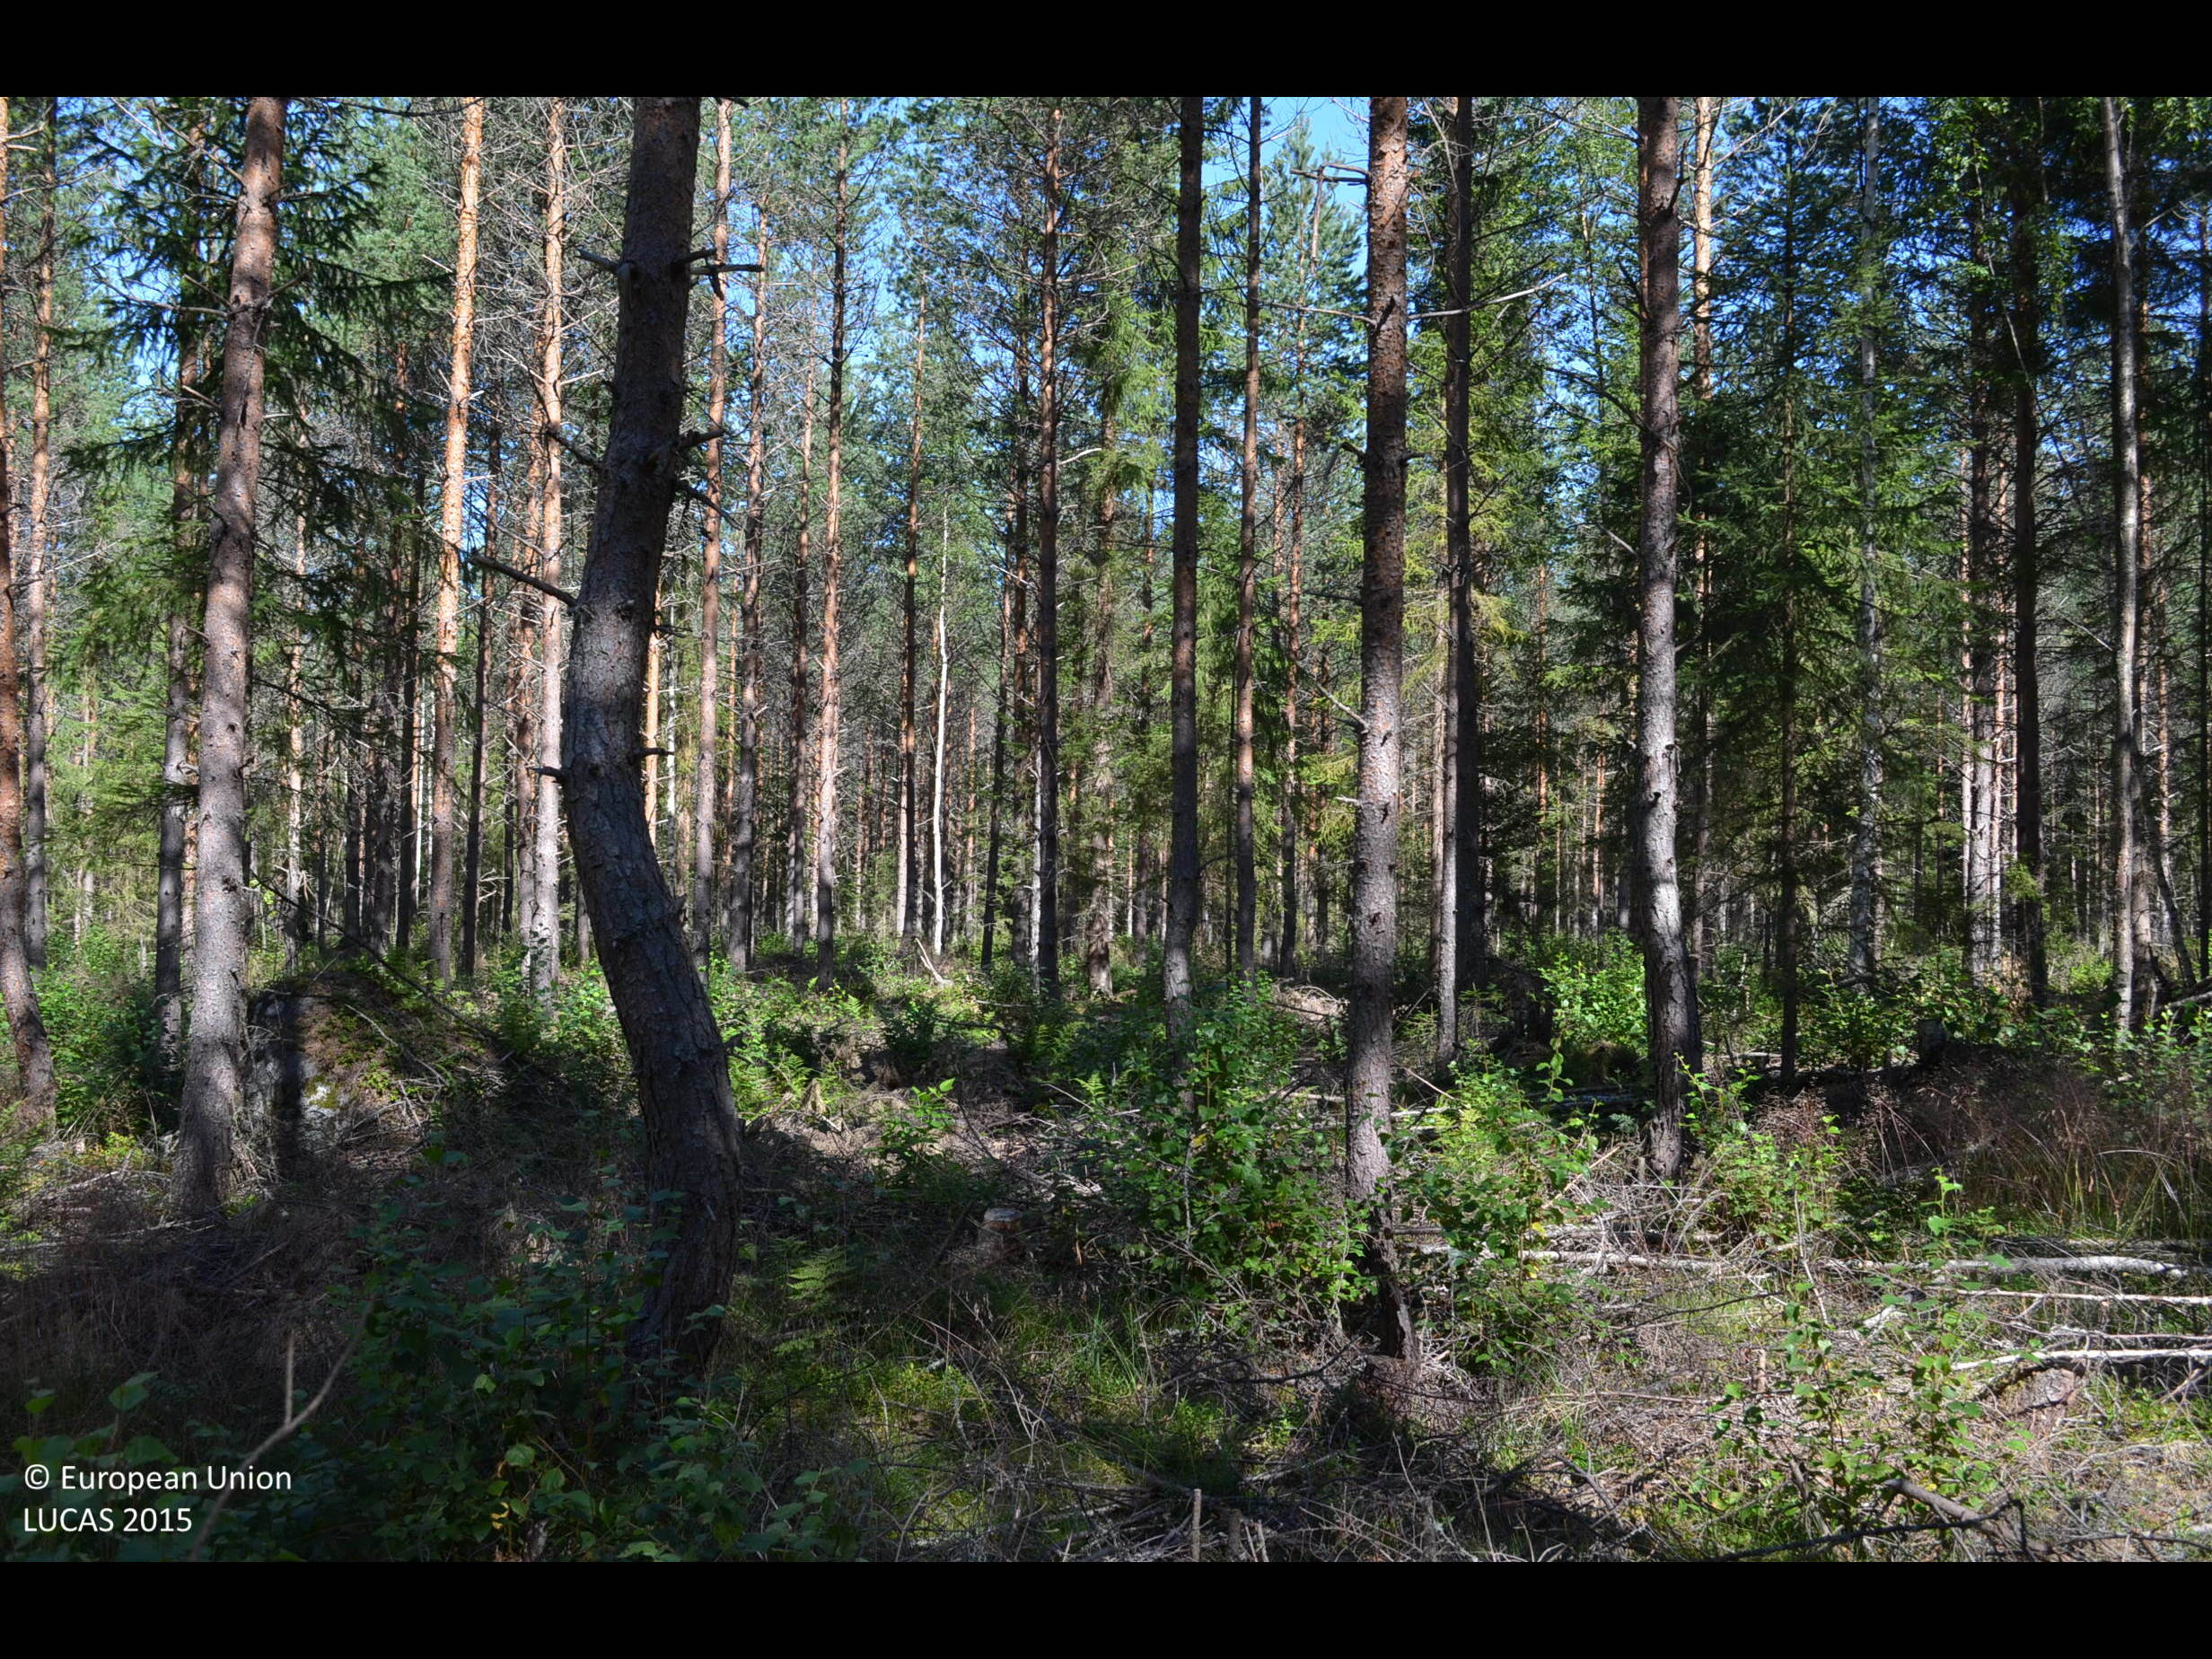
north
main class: Woodland
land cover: Pine dominated coniferous woodland
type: boreal forest
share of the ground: 50 - 75 %
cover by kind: coniferous forest trees 70 %, shrubs 20 %, herbaceous plants 5 %
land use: Forestry
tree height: > 5 m
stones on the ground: < 10 %
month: August
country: FI
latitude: 62.3456
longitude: 24.3211
